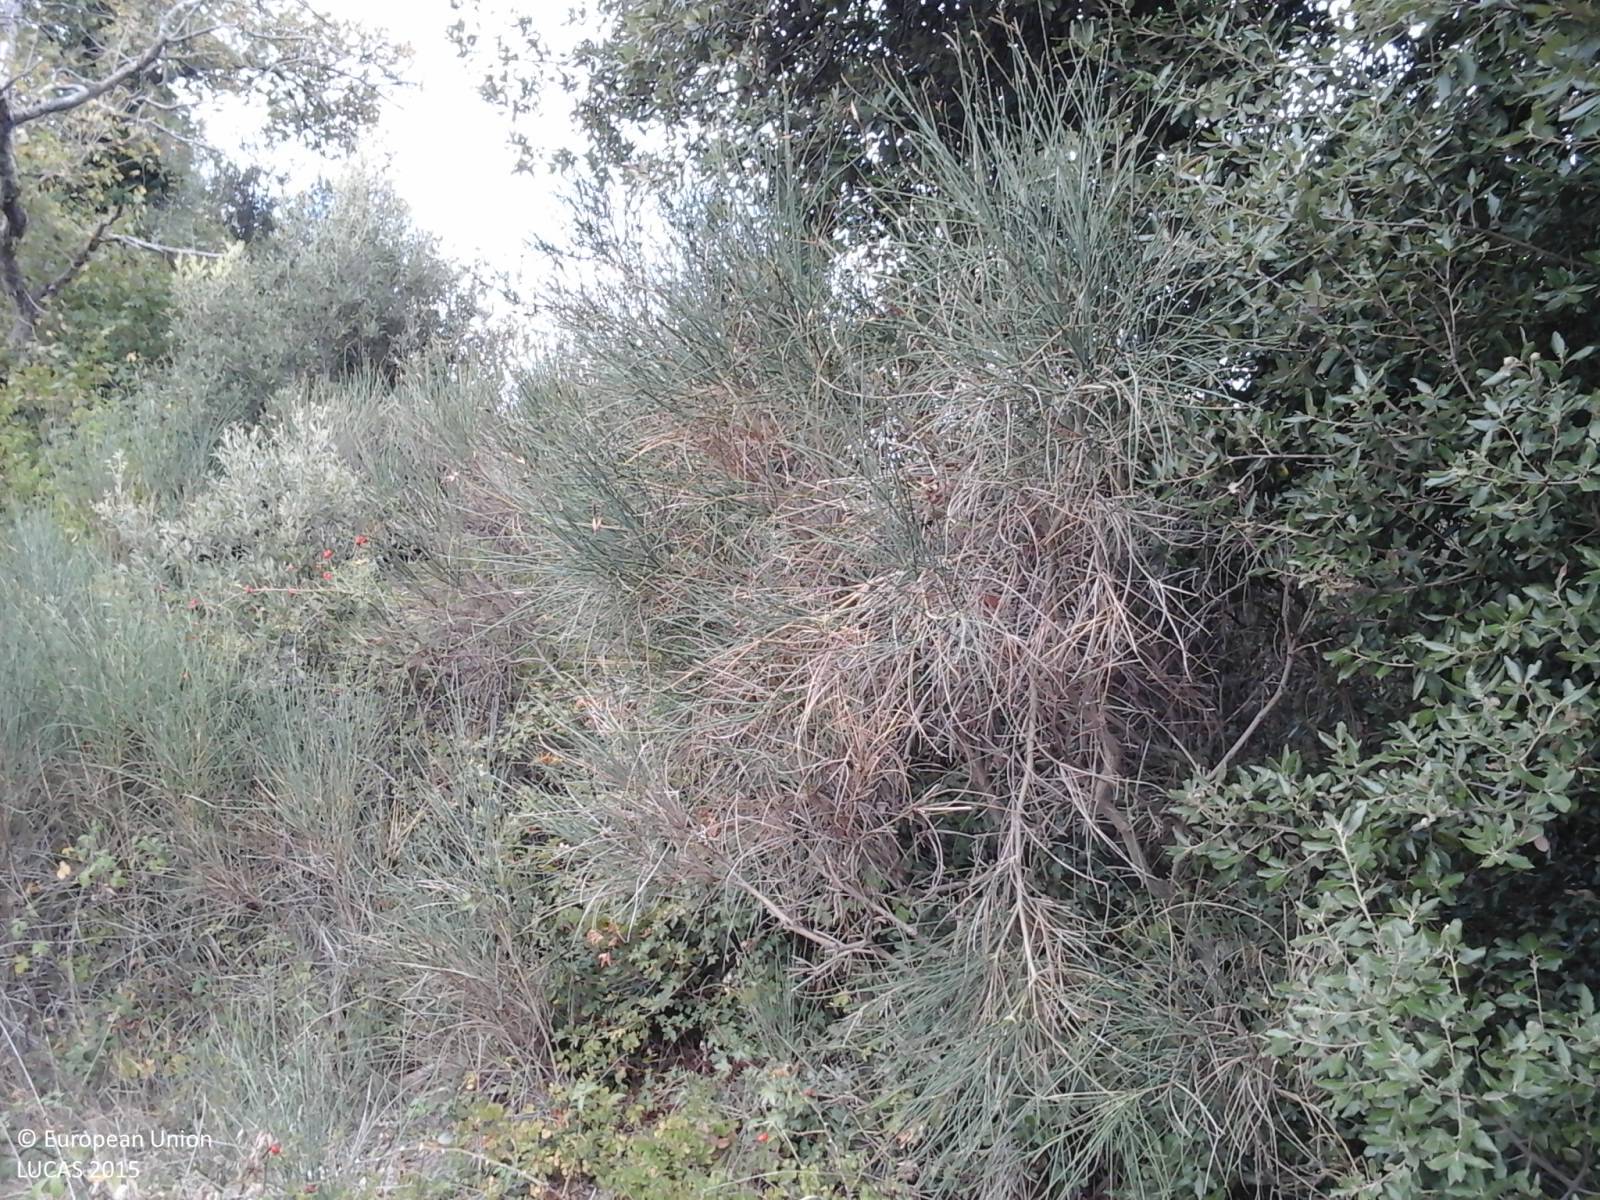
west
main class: Grassland
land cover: Grassland without tree/shrub cover
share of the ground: > 75 %
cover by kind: herbaceous plants 100 %
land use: Agriculture (excluding fallow land and kitchen gardens)
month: September
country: IT
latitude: 43.1333
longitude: 12.3167
